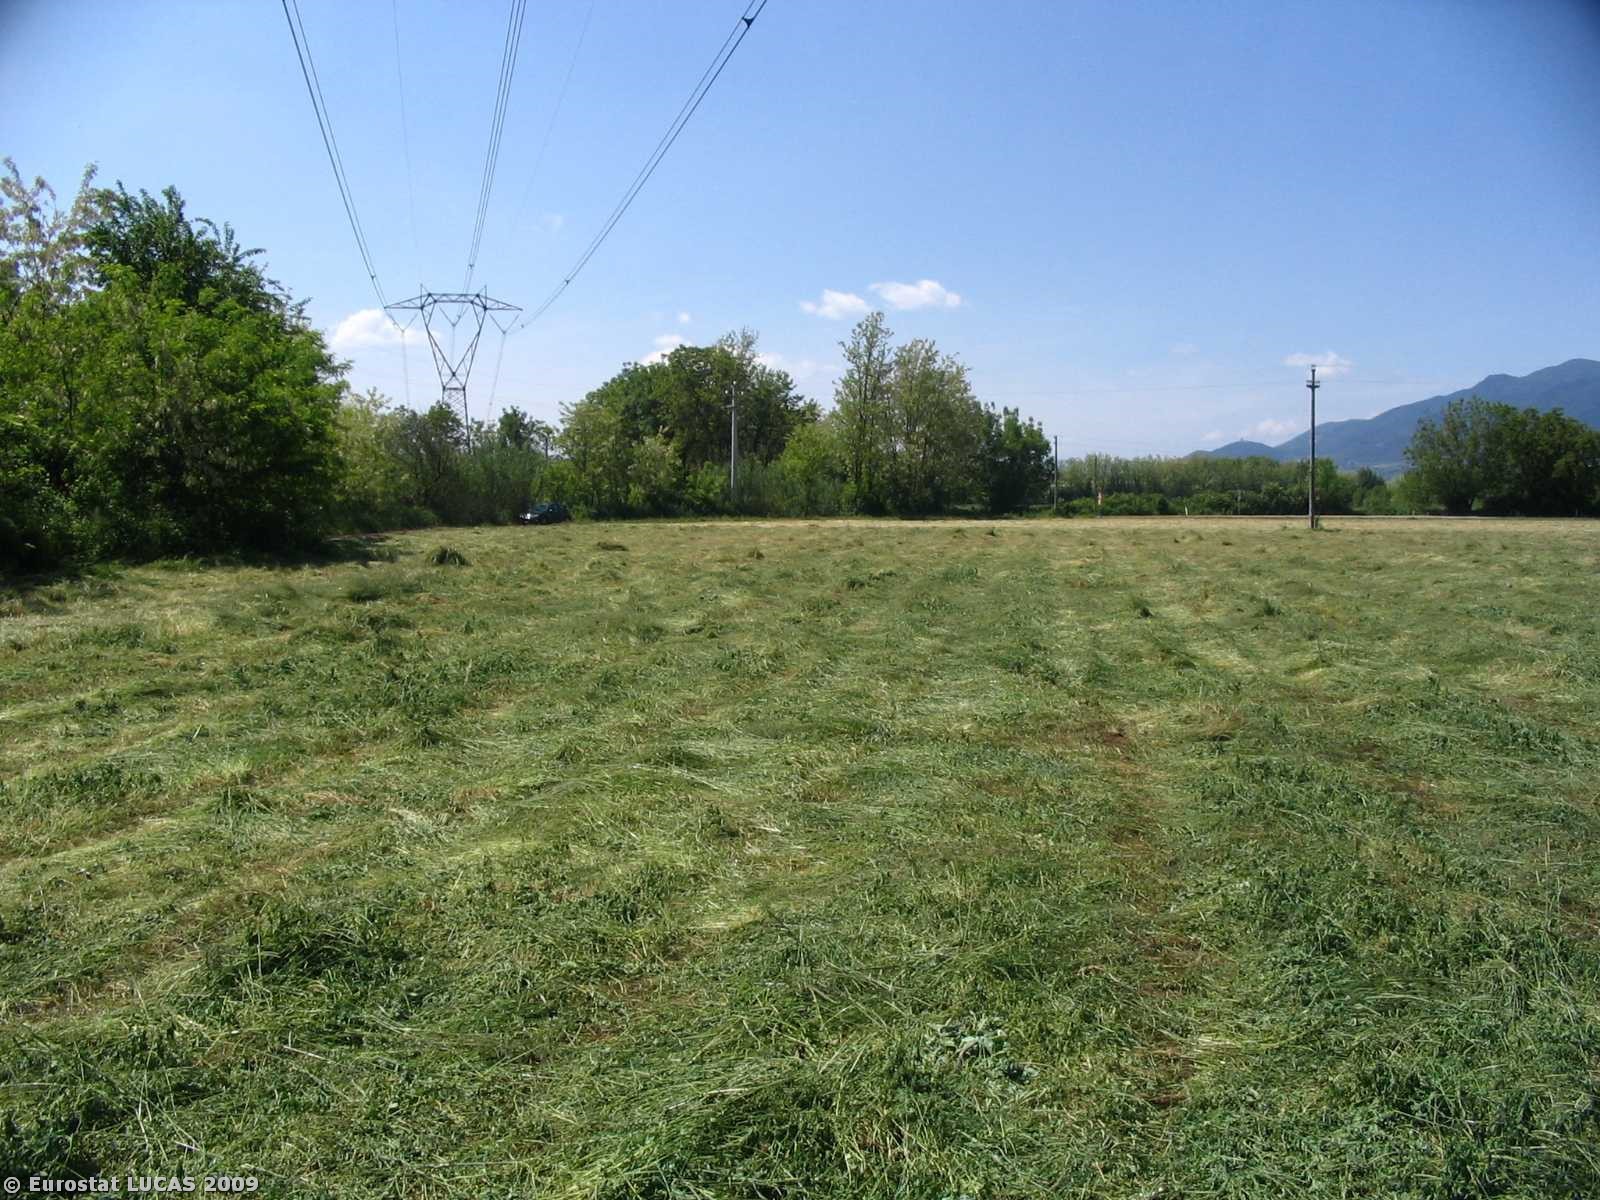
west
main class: Cropland
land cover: Lucerne
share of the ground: < 10 %
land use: Agriculture (excluding fallow land and kitchen gardens)
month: May
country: IT
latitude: 41.2943
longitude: 14.3423
